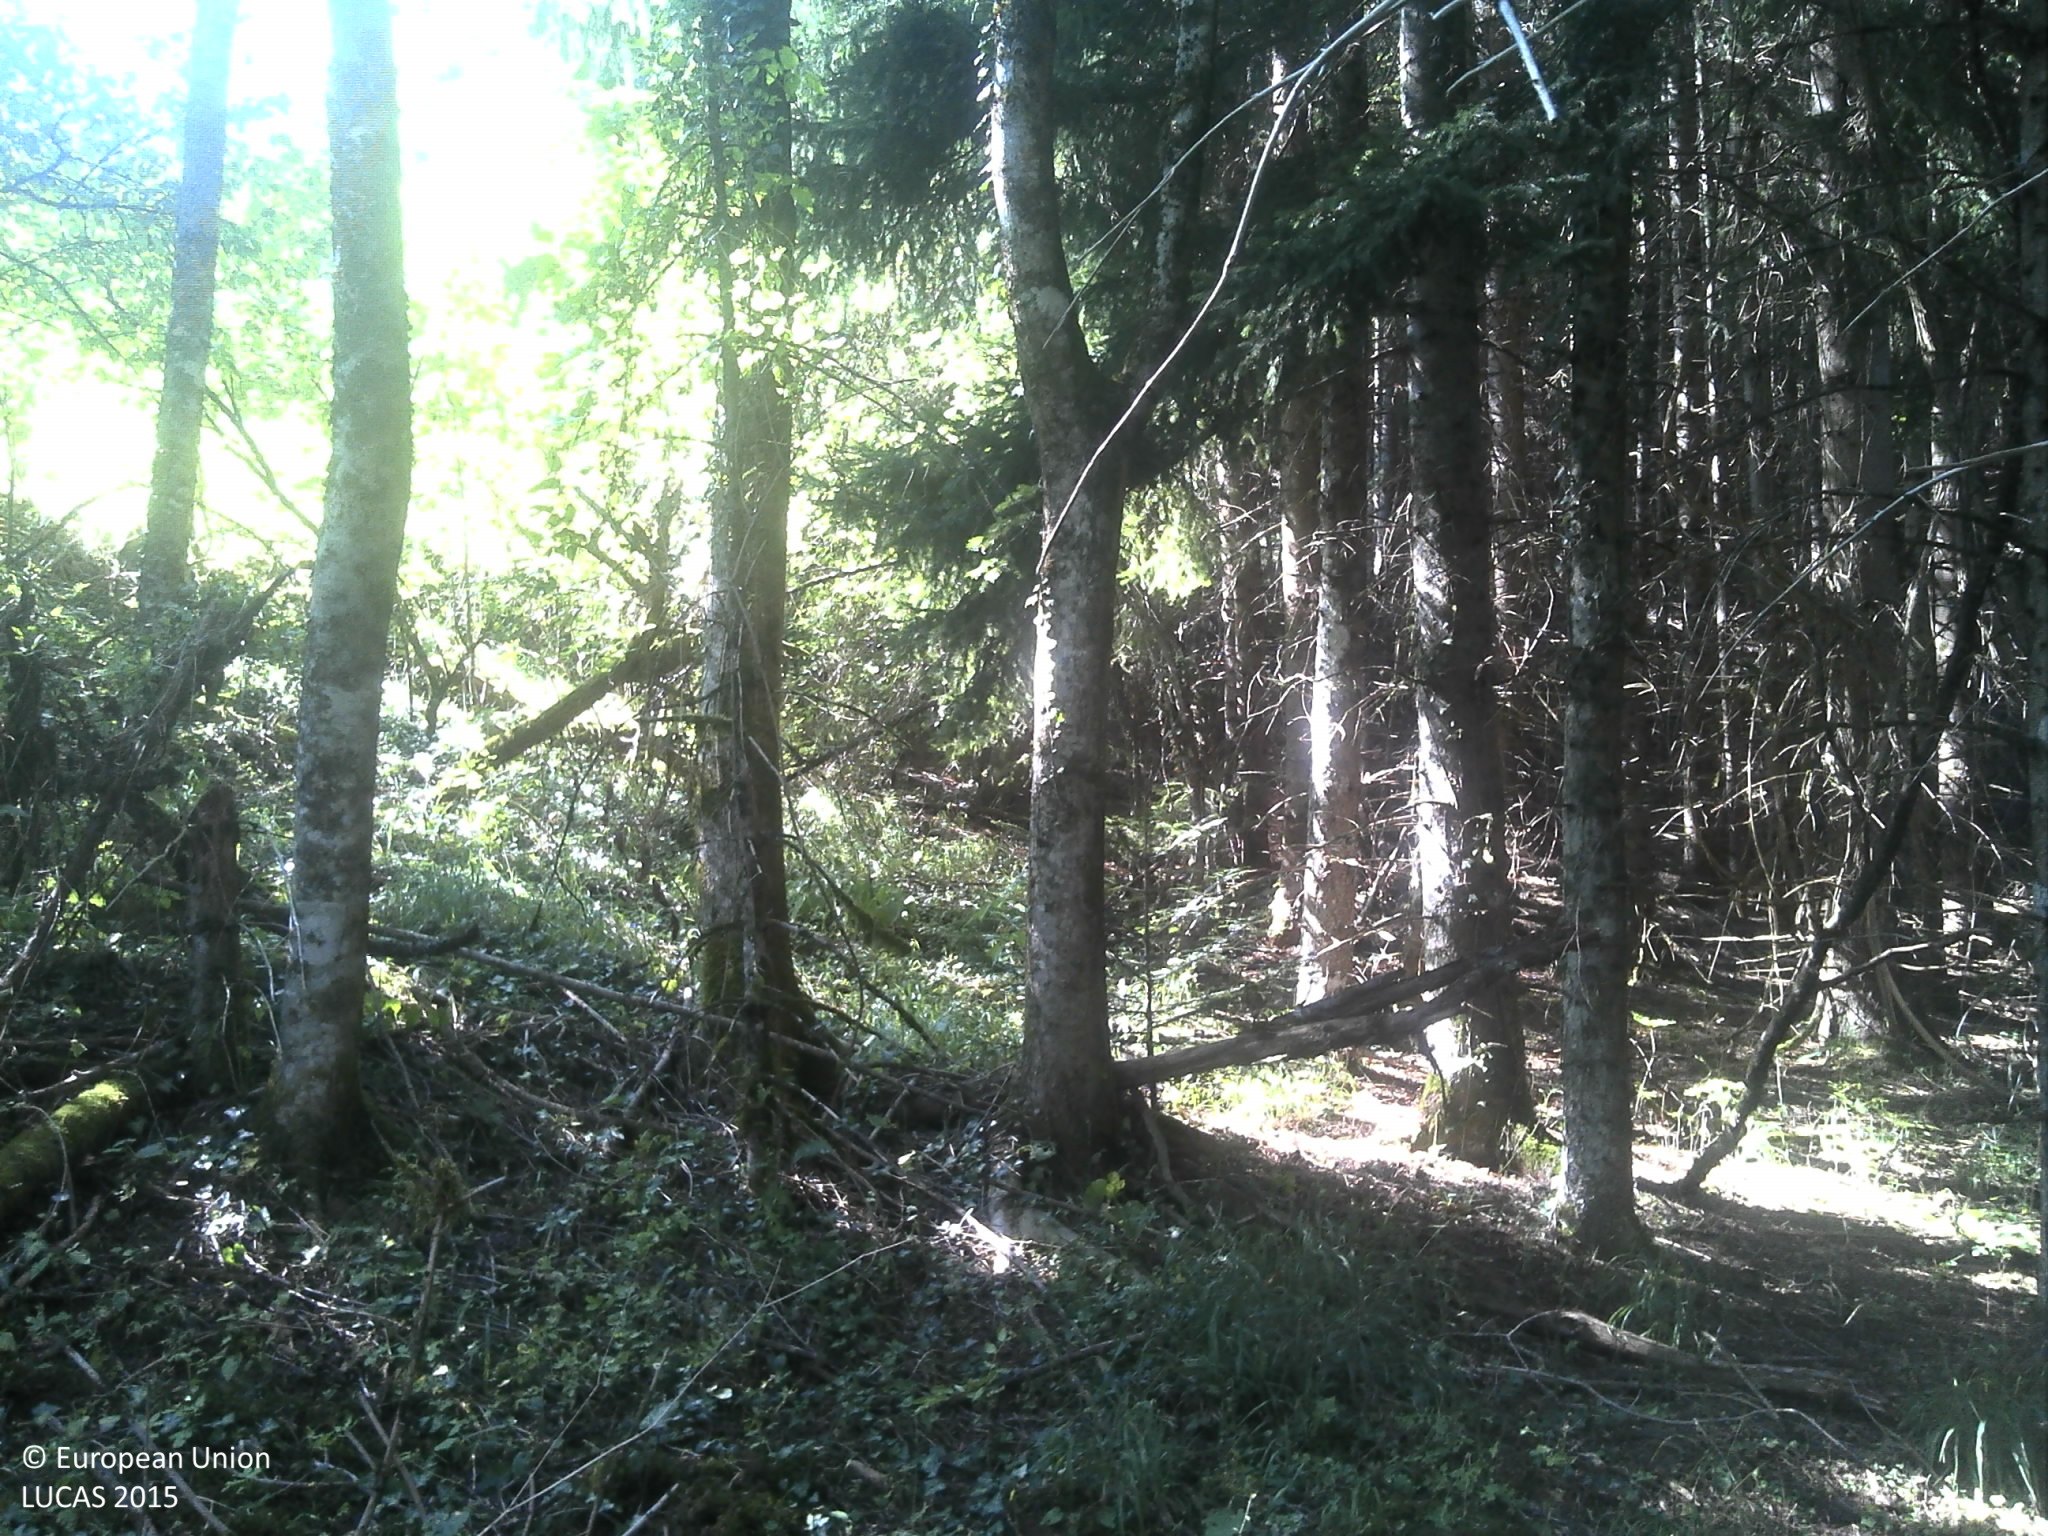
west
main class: Woodland
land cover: Spruce dominated coniferous woodland
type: alpine coniferous forest
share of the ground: > 75 %
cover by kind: coniferous forest trees 75 %, broadleaved forest trees 10 %, herbaceous plants 5 %, lichens and mosses 5 %, consolidated bare surface 5 %
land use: Semi-natural and natural areas not in use
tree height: > 5 m
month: August
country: HR
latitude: 44.6872
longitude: 15.2552
